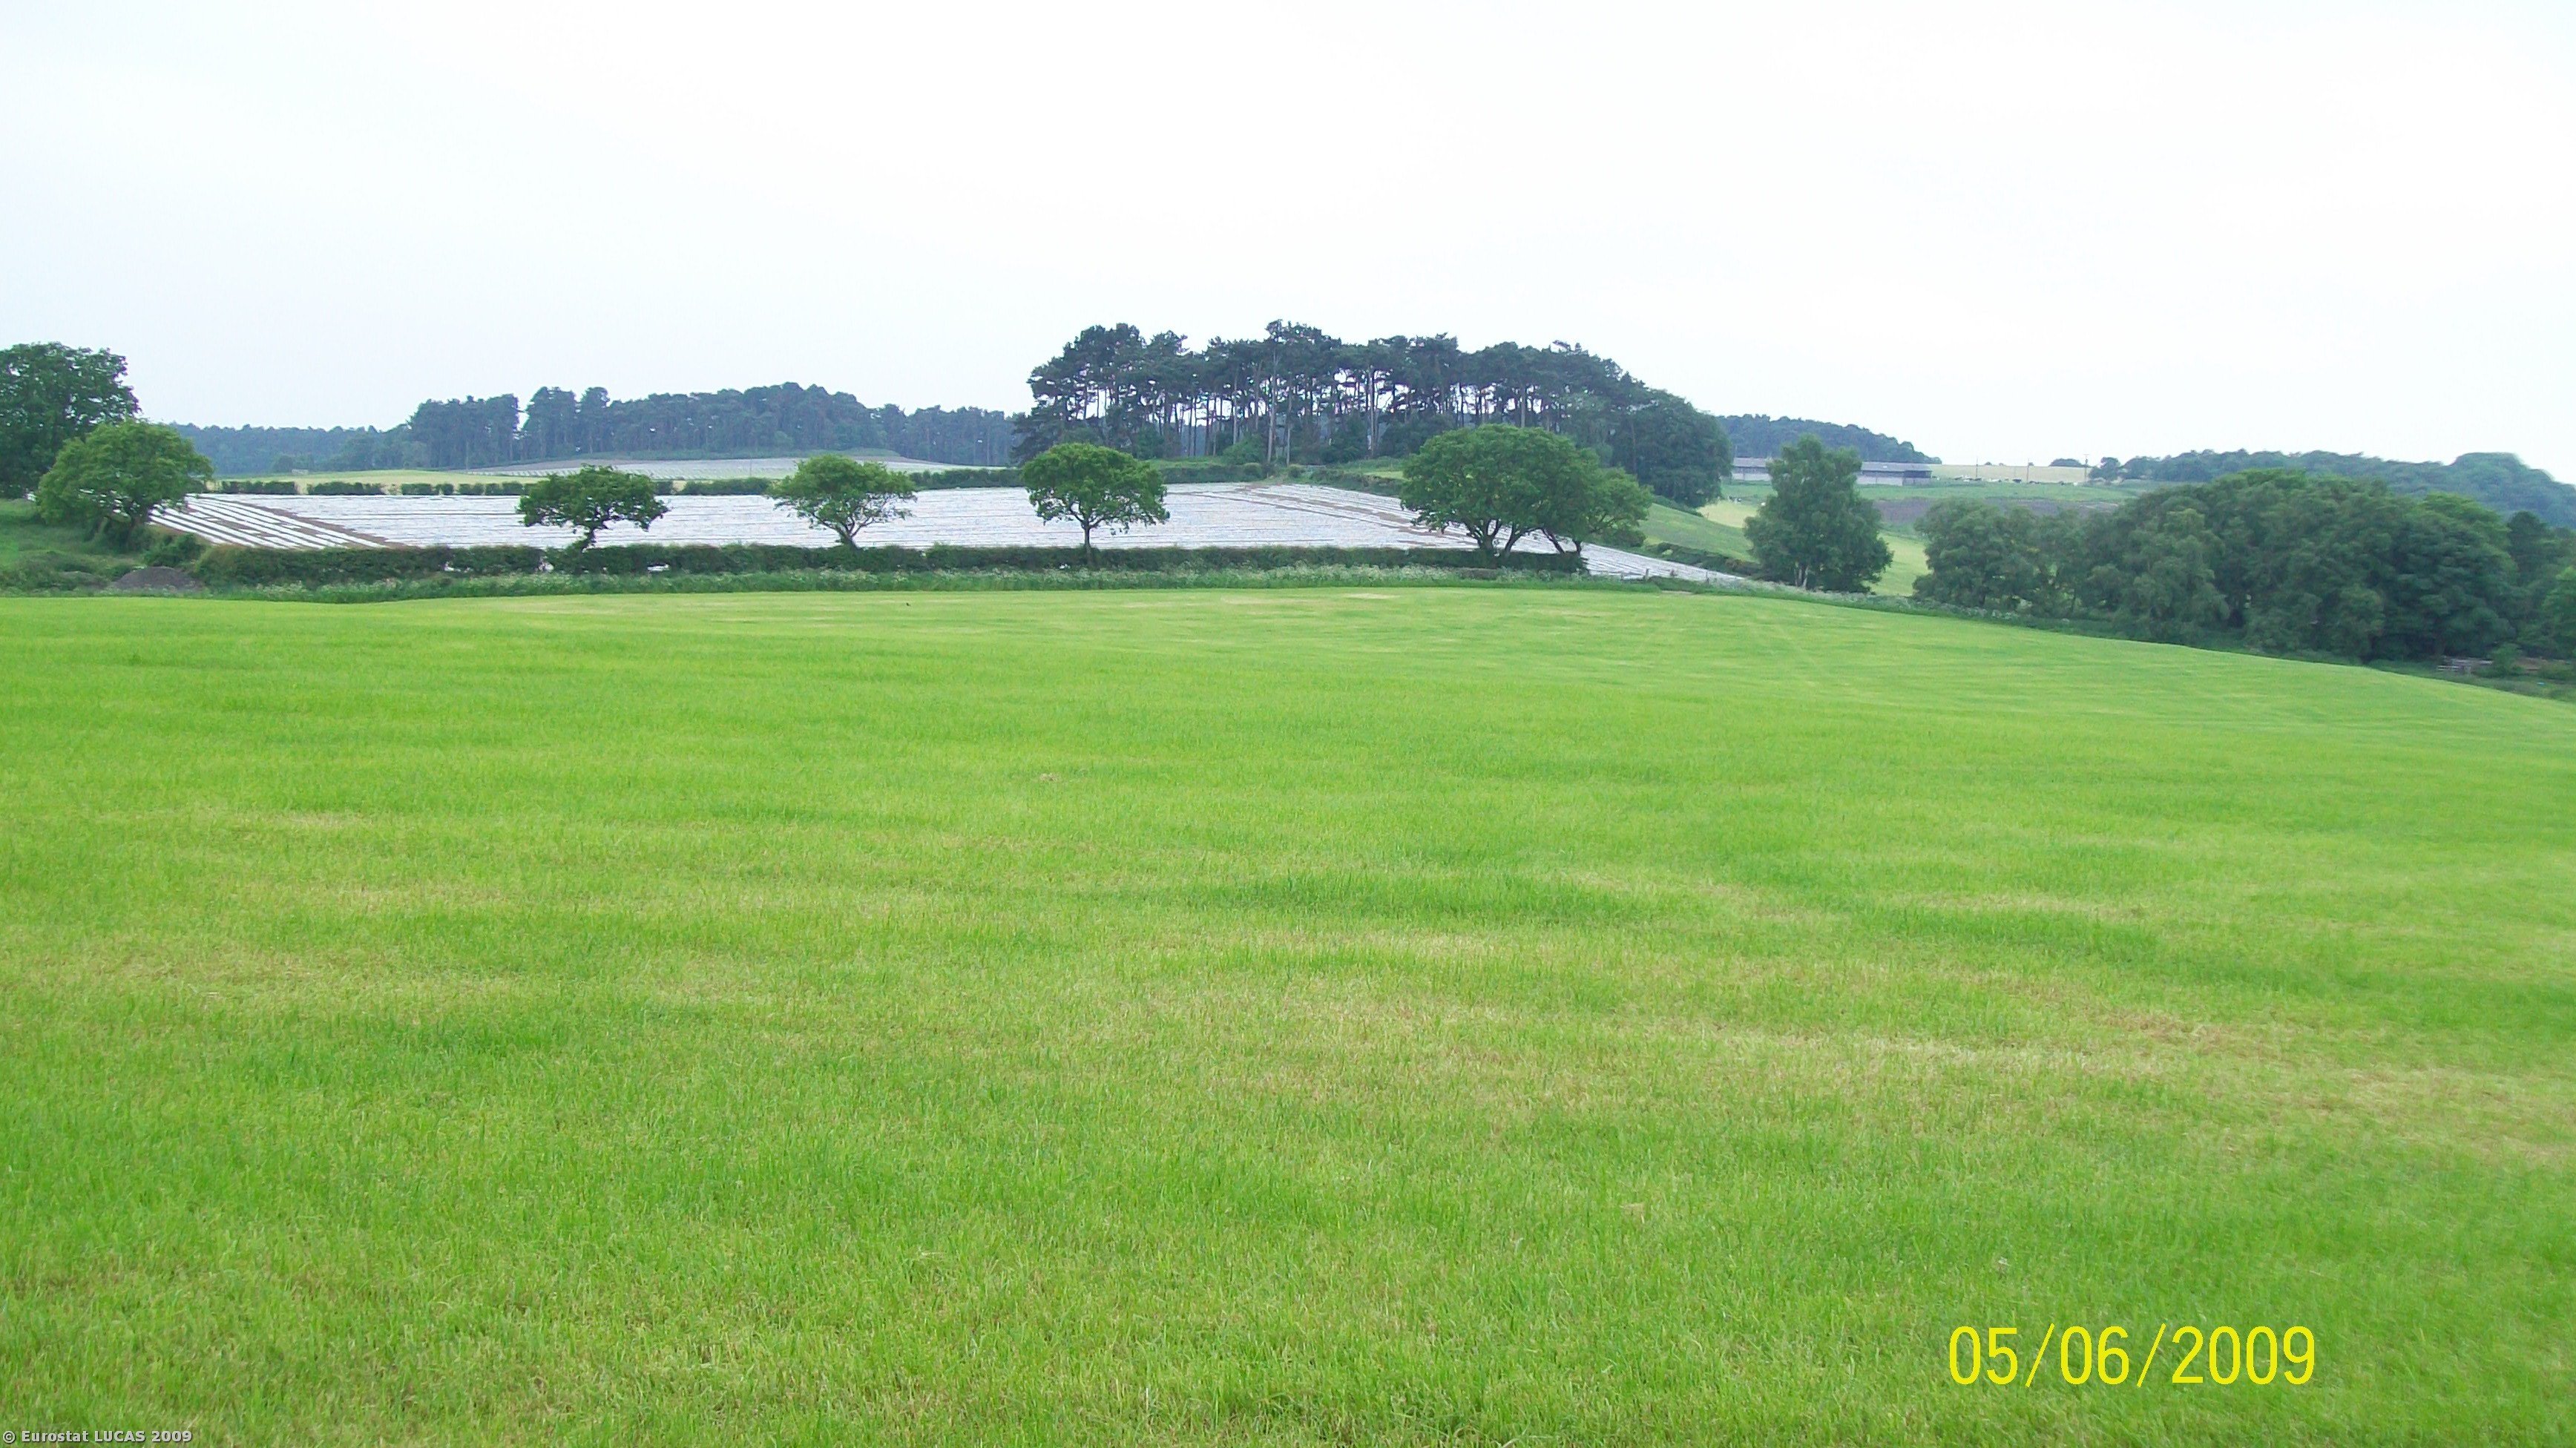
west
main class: Grassland
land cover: Grassland without tree/shrub cover
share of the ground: > 75 %
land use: Agriculture (excluding fallow land and kitchen gardens)
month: June
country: GB
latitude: 53.0922
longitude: -2.7174
